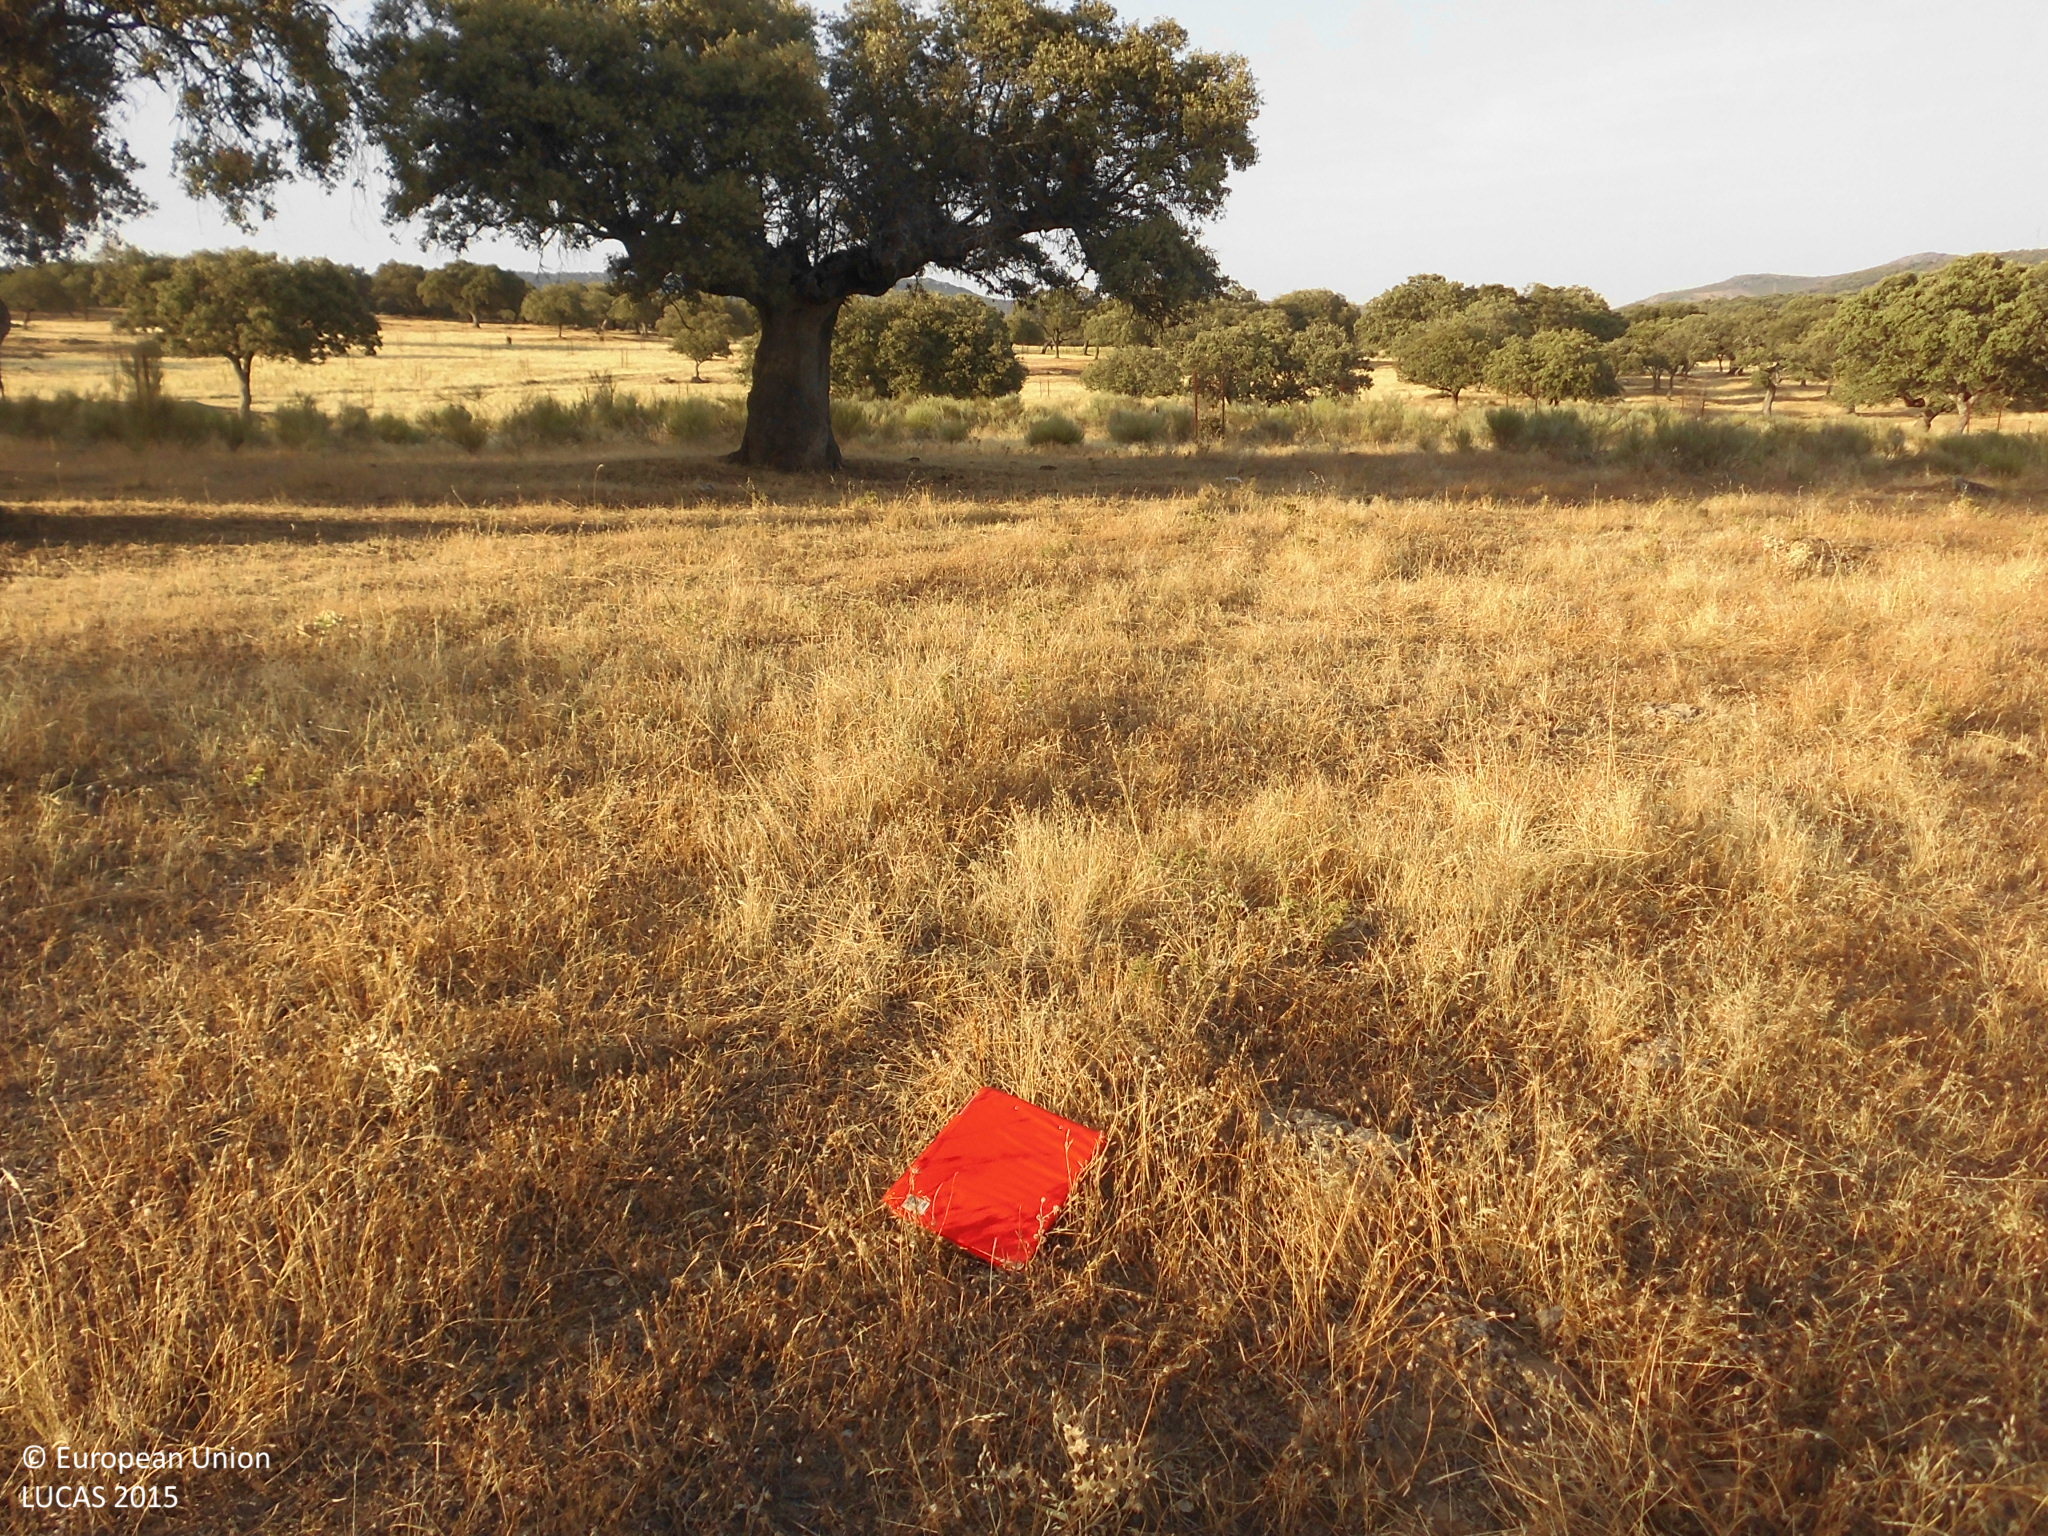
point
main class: Woodland
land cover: Broadleaved woodland
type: broadleaved evergreen forest
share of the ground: 10 - 25 %
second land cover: Grassland without tree/shrub cover
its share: > 75 %
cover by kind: herbaceous plants 90 %, broadleaved forest trees 10 %
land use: Forestry
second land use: Agriculture (excluding fallow land and kitchen gardens)
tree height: > 5 m
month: July
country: ES
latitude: 39.6269
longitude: -5.6563
